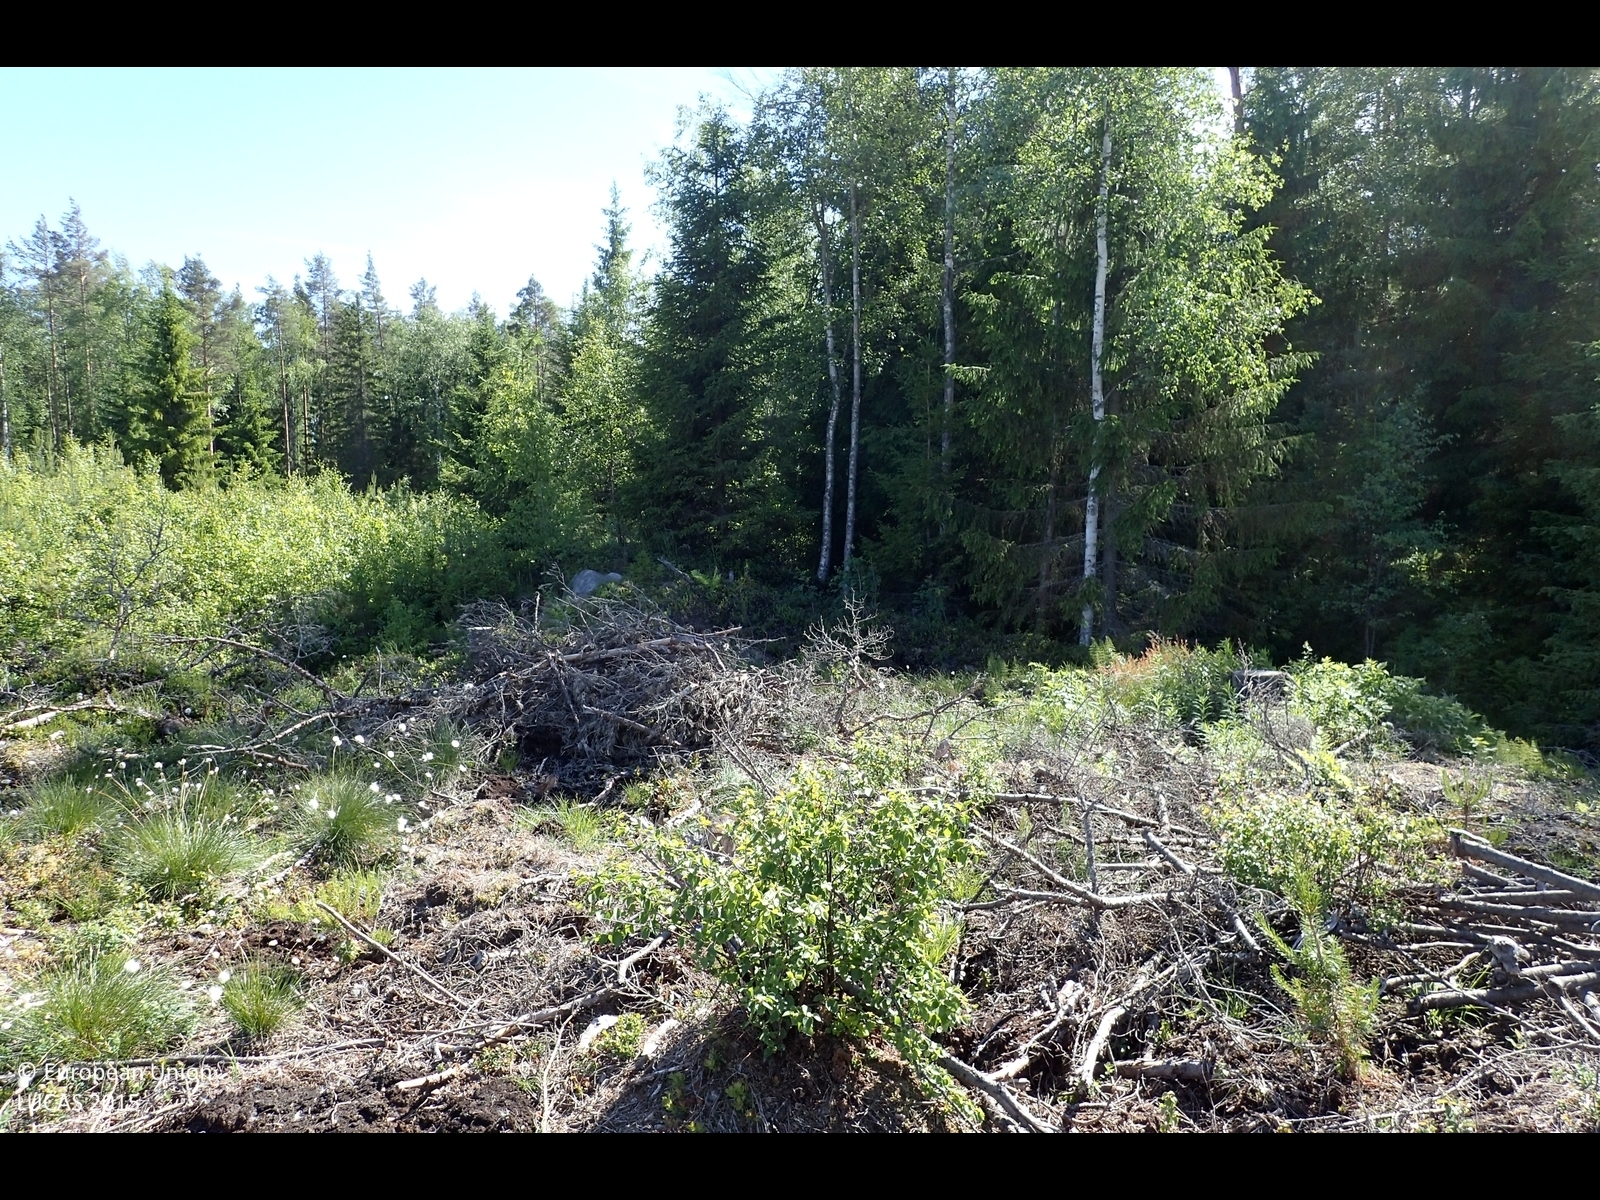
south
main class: Woodland
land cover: Broadleaved woodland
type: mire and swamp forests
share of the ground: 10 - 25 %
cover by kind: unconsolidated bare surface 25 %, herbaceous plants 15 %, broadleaved forest trees 10 %, shrubs 5 %
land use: Forestry
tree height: < 5 m
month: July
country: FI
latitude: 62.5922
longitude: 21.7091
